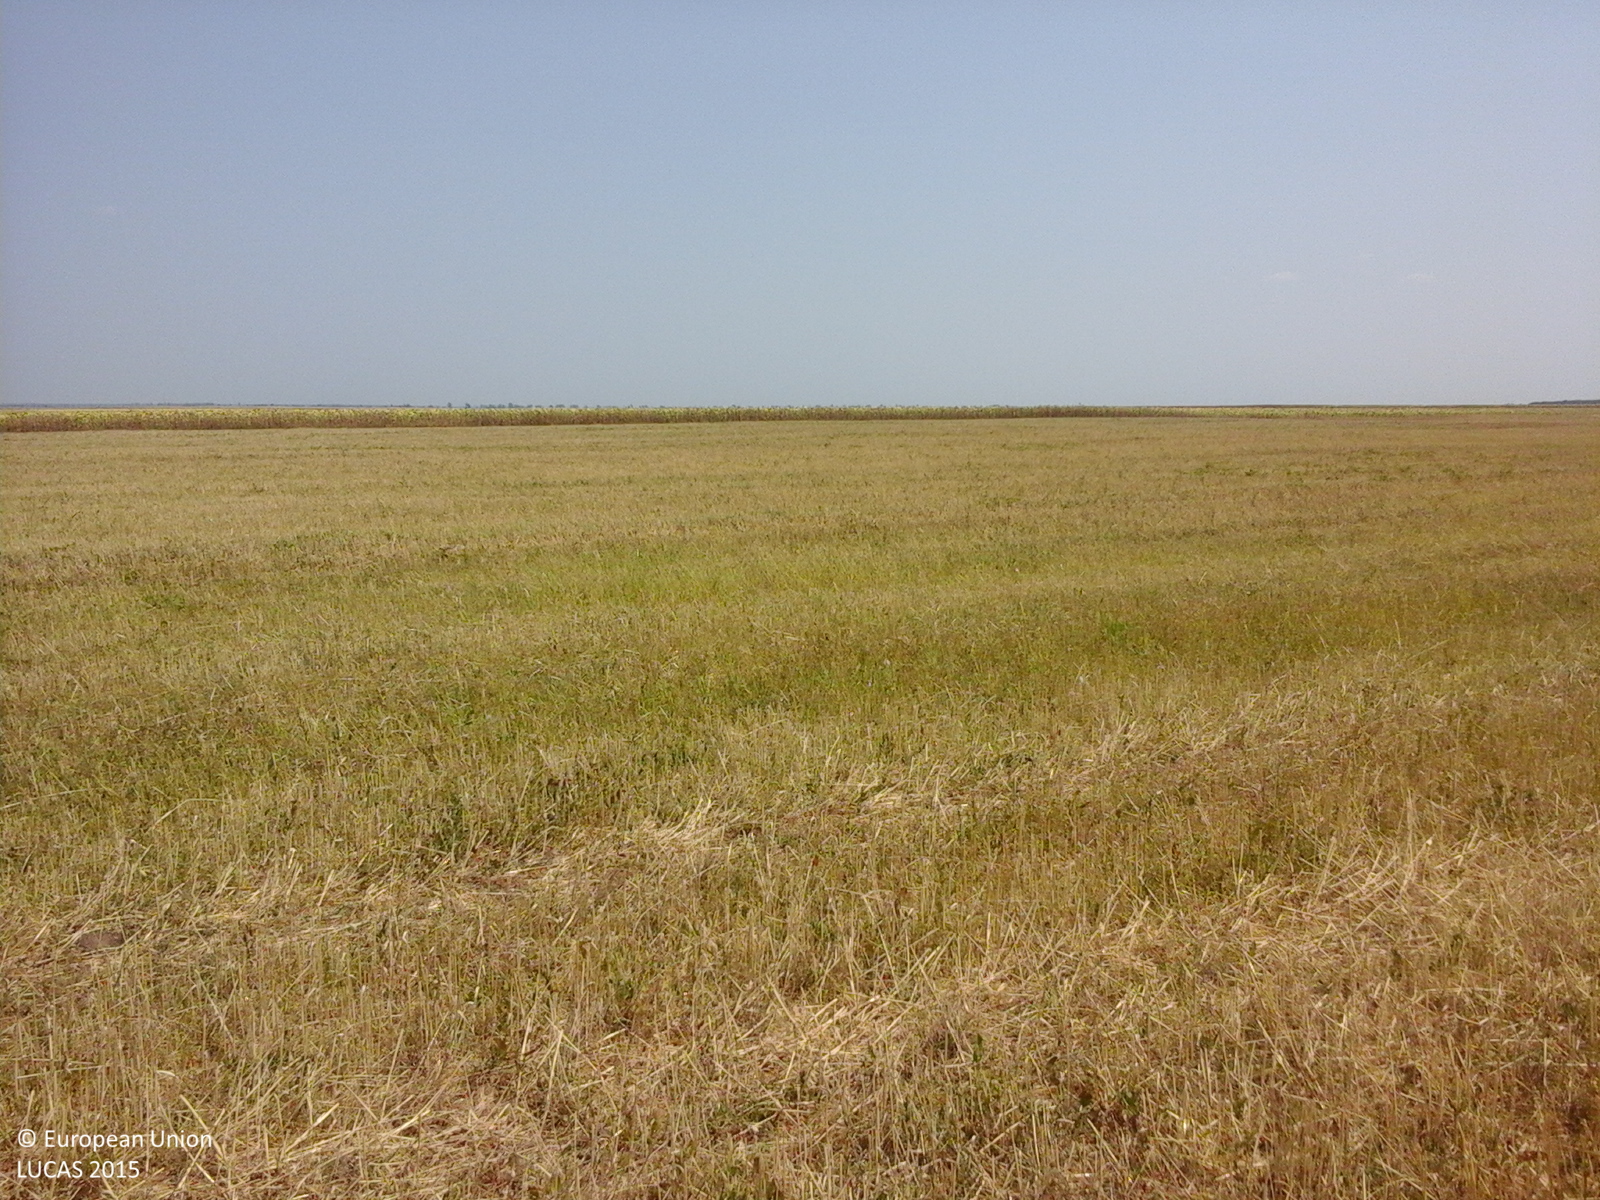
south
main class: Cropland
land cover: Sunflower
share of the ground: > 75 %
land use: Agriculture (excluding fallow land and kitchen gardens)
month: August
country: RO
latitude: 44.2522
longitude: 23.3367
